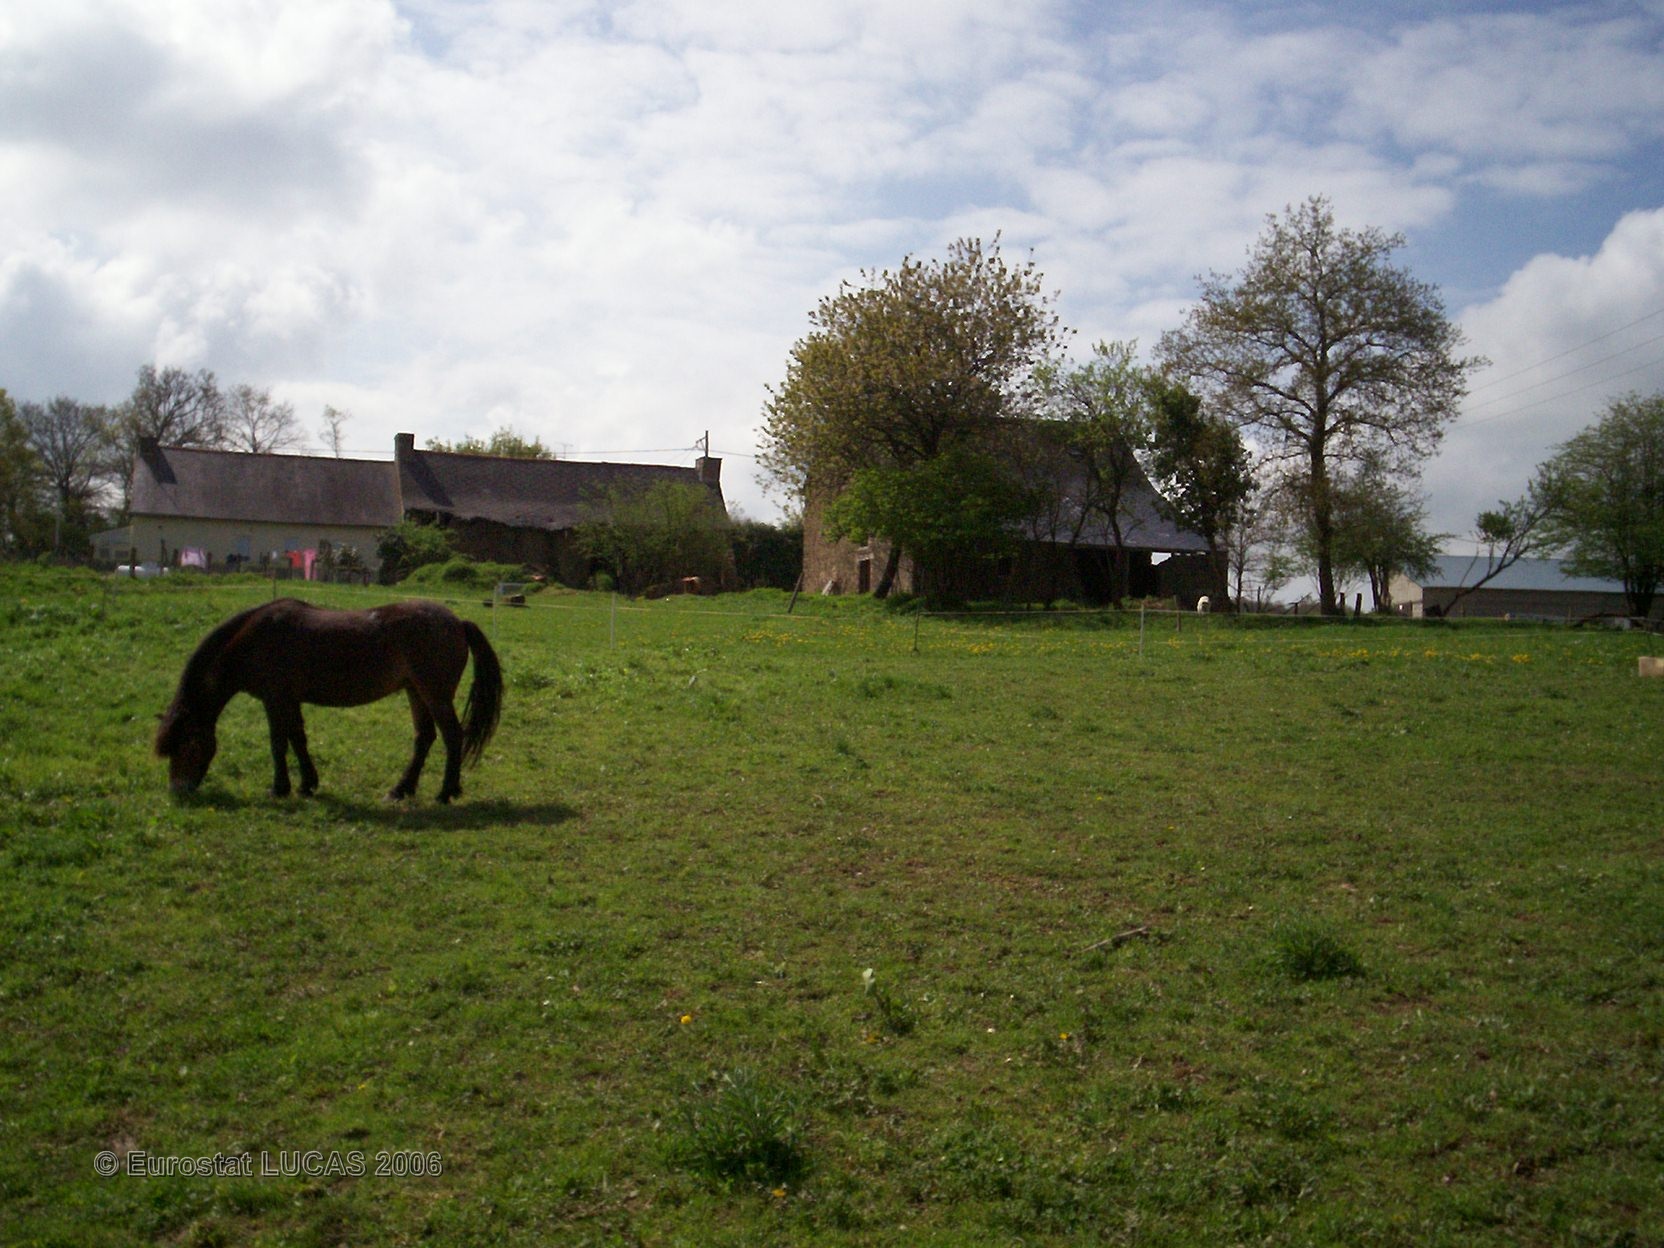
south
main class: Grassland
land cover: Grassland without tree/shrub cover
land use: Agriculture (excluding fallow land and kitchen gardens)
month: April
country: FR
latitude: 48.0497
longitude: -2.3868
